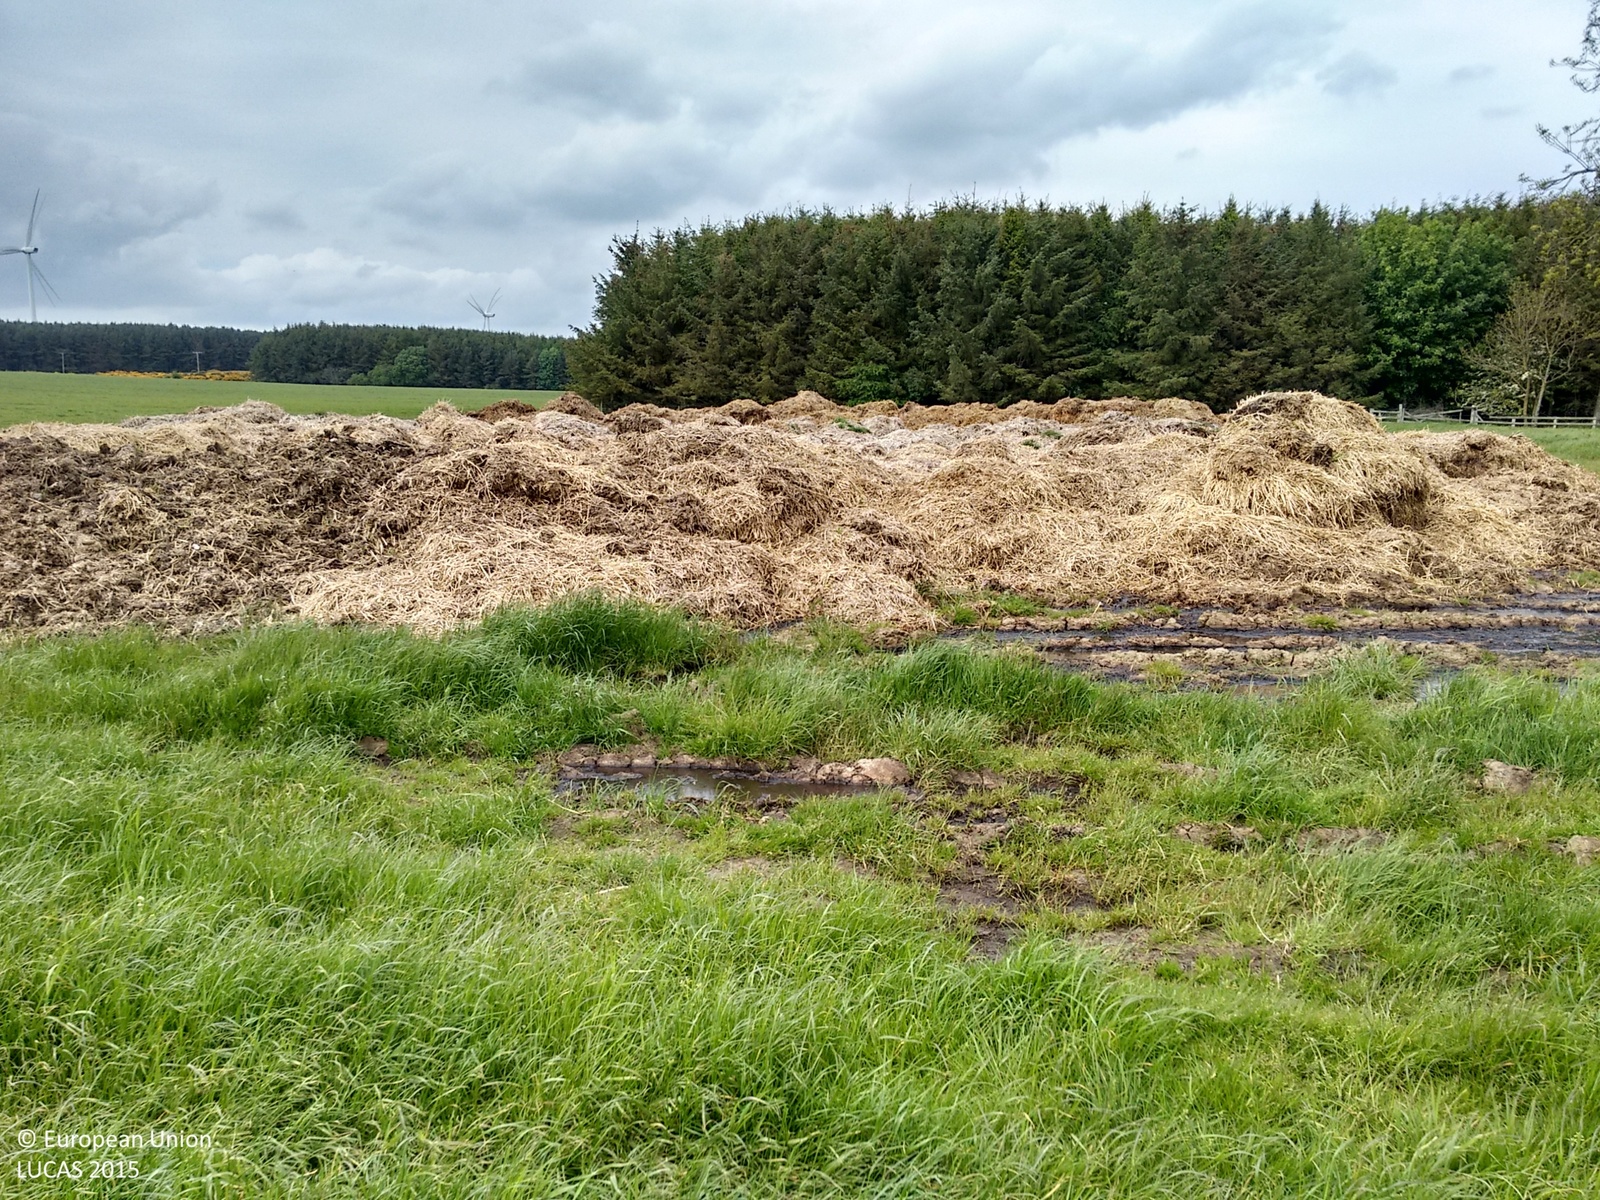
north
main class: Cropland
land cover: Temporary grasslands
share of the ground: > 75 %
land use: Agriculture (excluding fallow land and kitchen gardens)
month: June
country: GB
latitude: 55.4827
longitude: -1.7431
